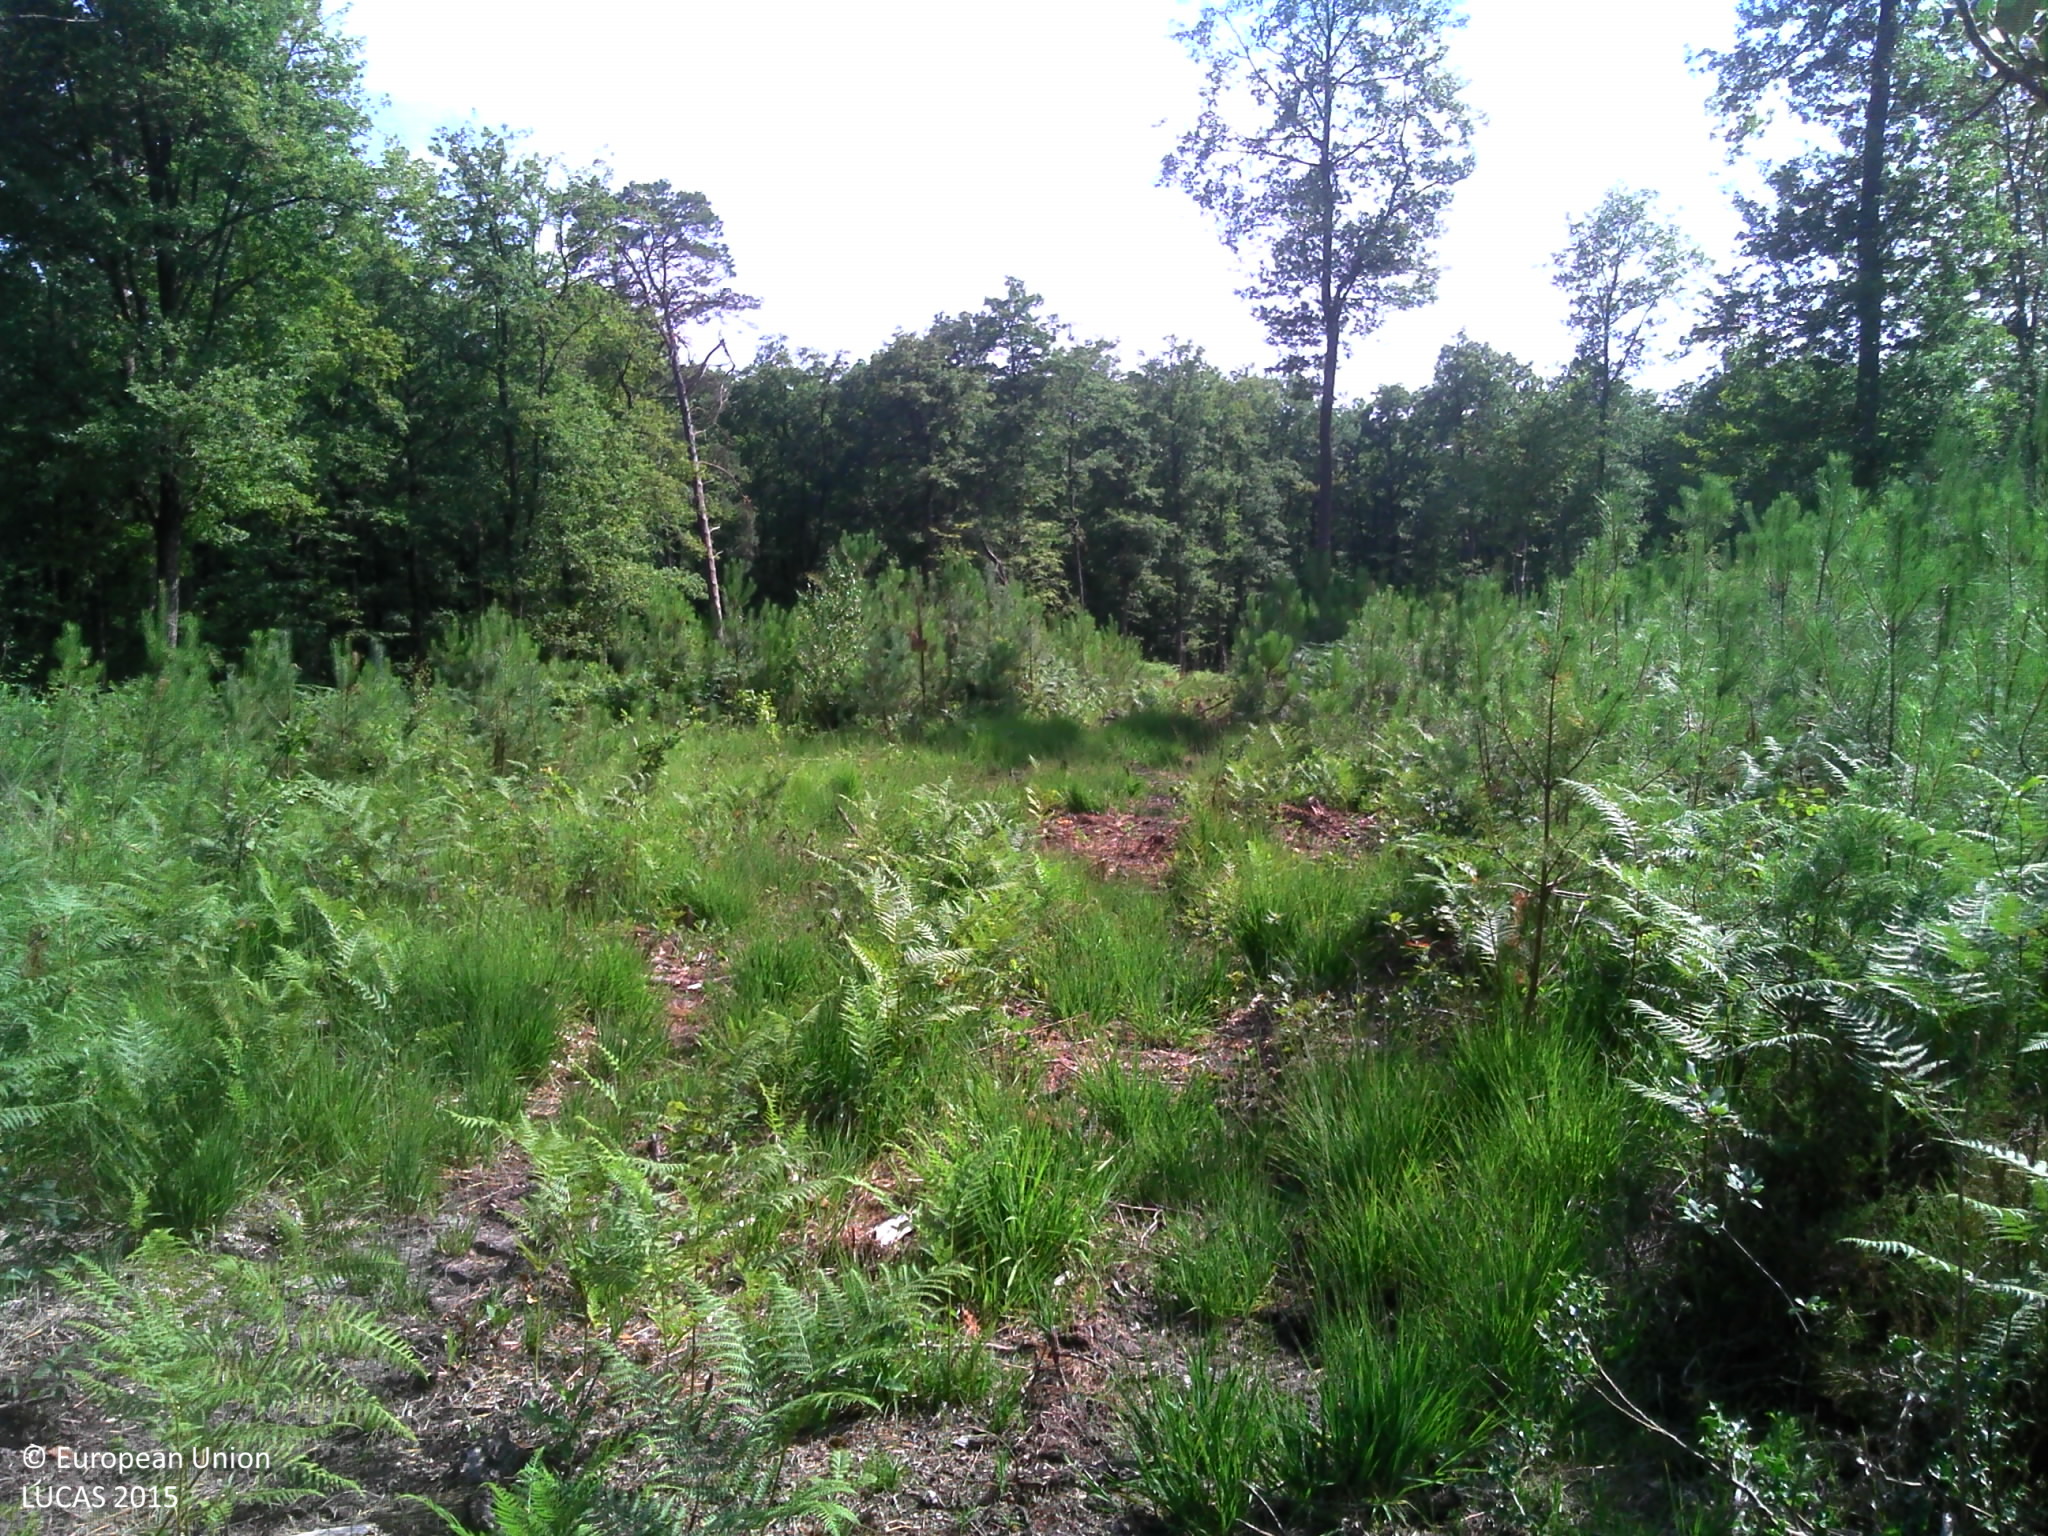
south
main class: Woodland
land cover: Pine dominated mixed woodland
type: exotic forest
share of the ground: > 75 %
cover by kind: coniferous forest trees 40 %, broadleaved forest trees 25 %, shrubs 20 %, herbaceous plants 10 %, lichens and mosses 5 %
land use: Forestry
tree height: < 5 m
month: July
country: FR
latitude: 47.2396
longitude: 0.3747
